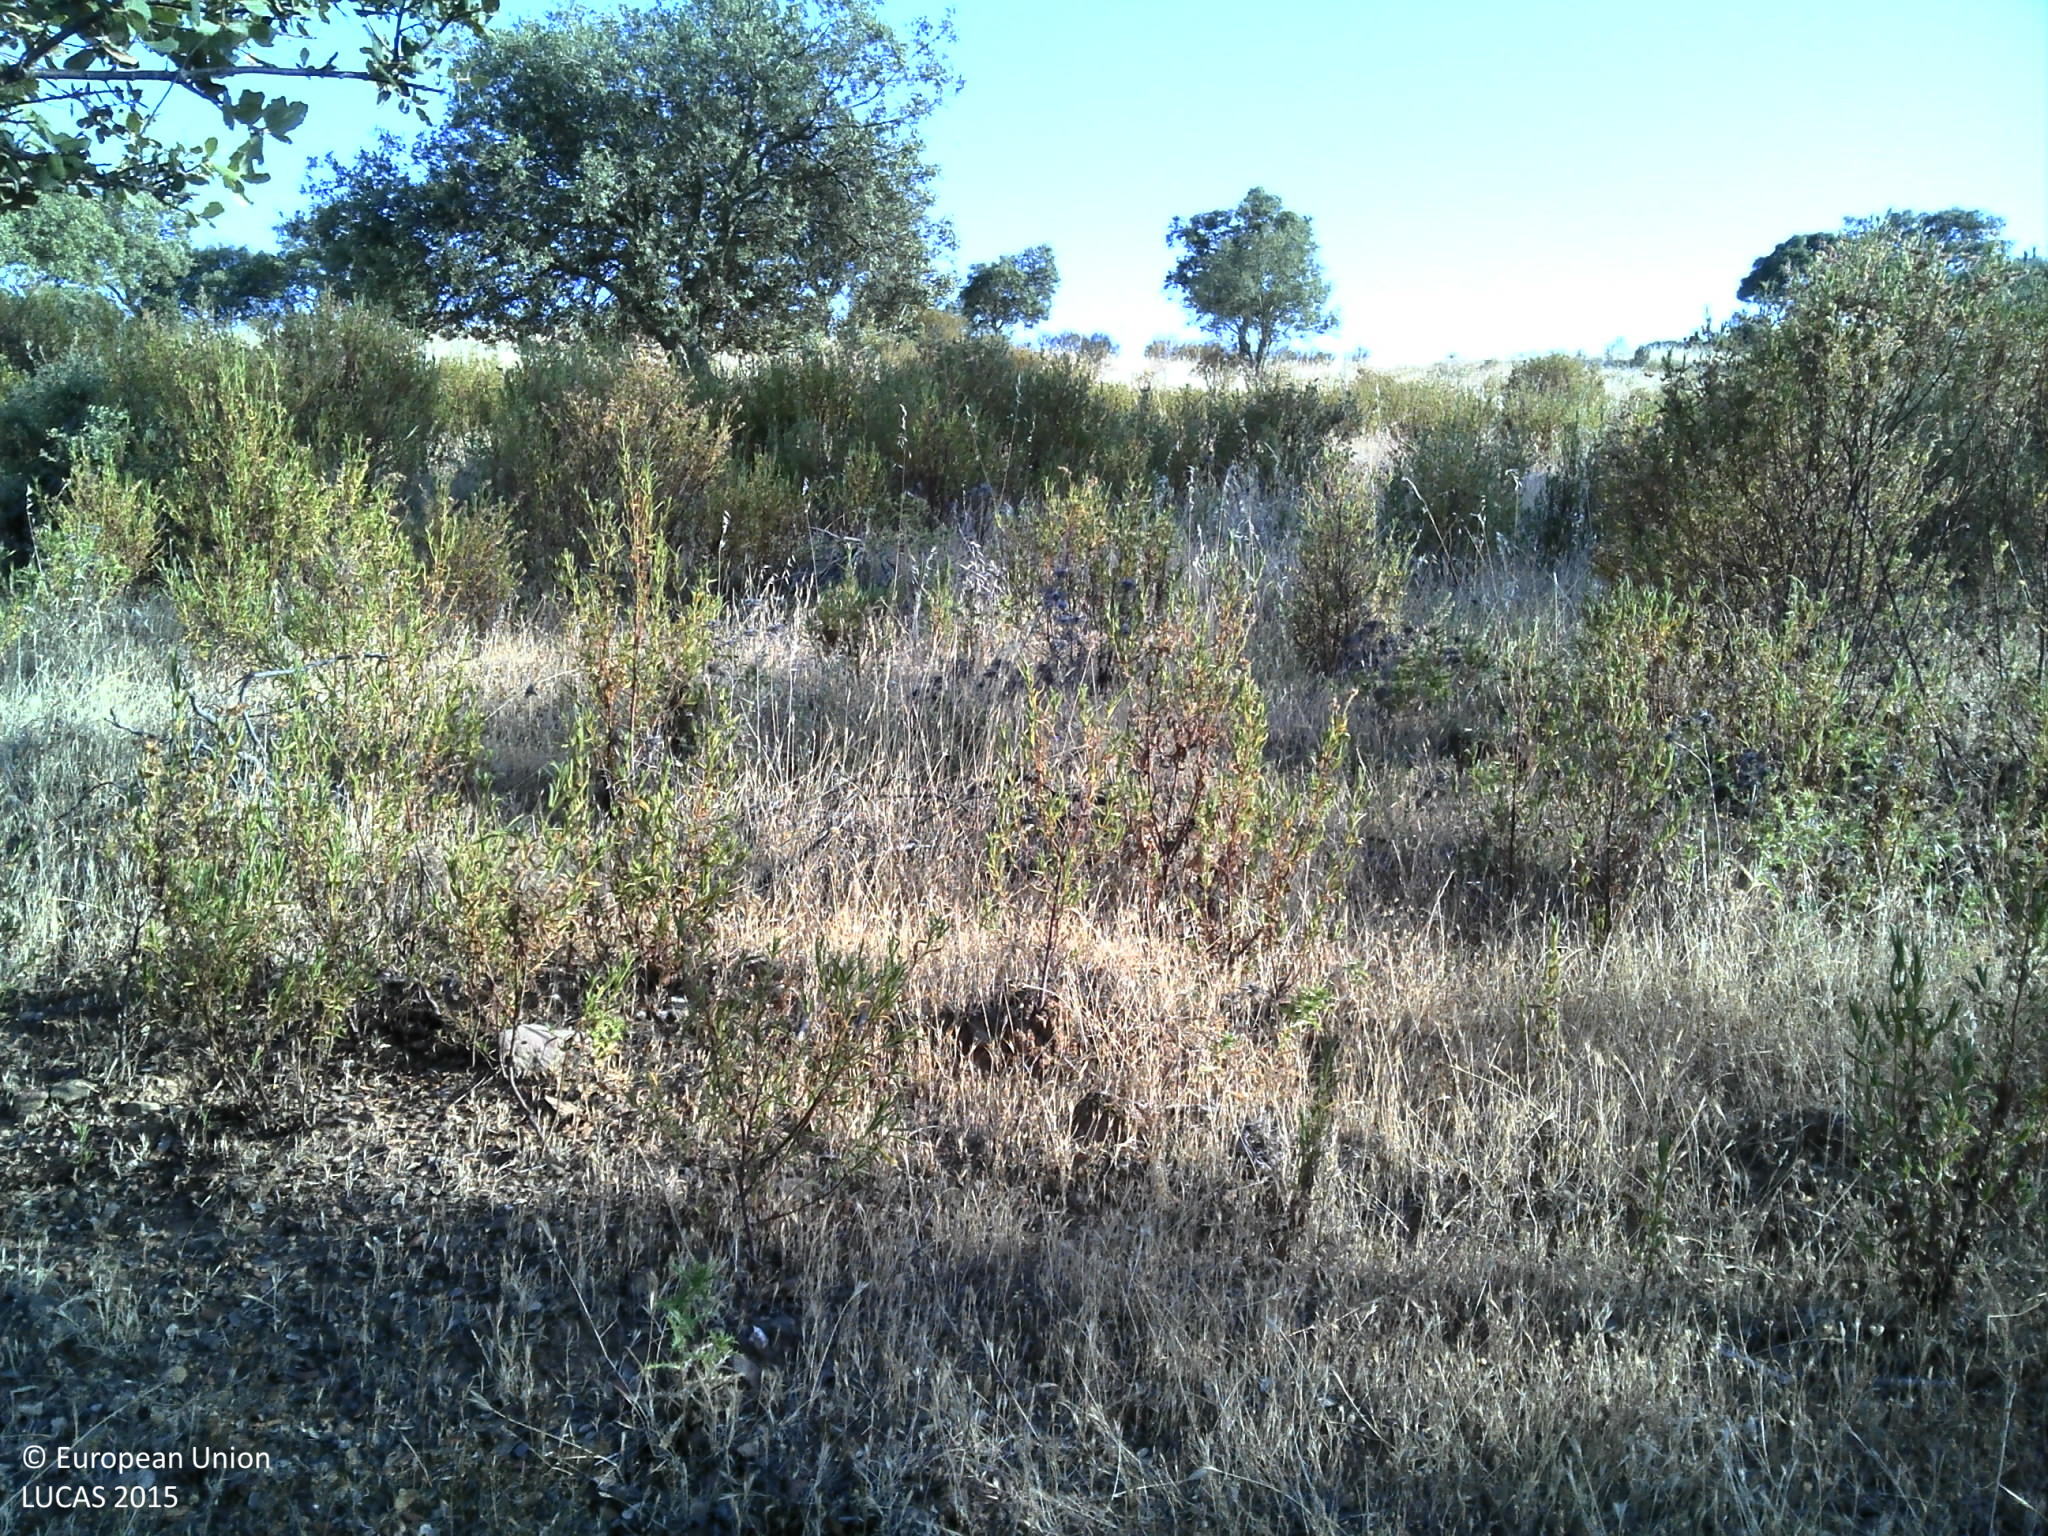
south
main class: Woodland
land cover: Broadleaved woodland
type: broadleaved evergreen forest
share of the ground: 25 - 50 %
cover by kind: broadleaved forest trees 50 %, shrubs 25 %, herbaceous plants 15 %, unconsolidated bare surface 10 %
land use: Forestry
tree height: < 5 m
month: June
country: PT
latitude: 37.5942
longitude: -7.5791
